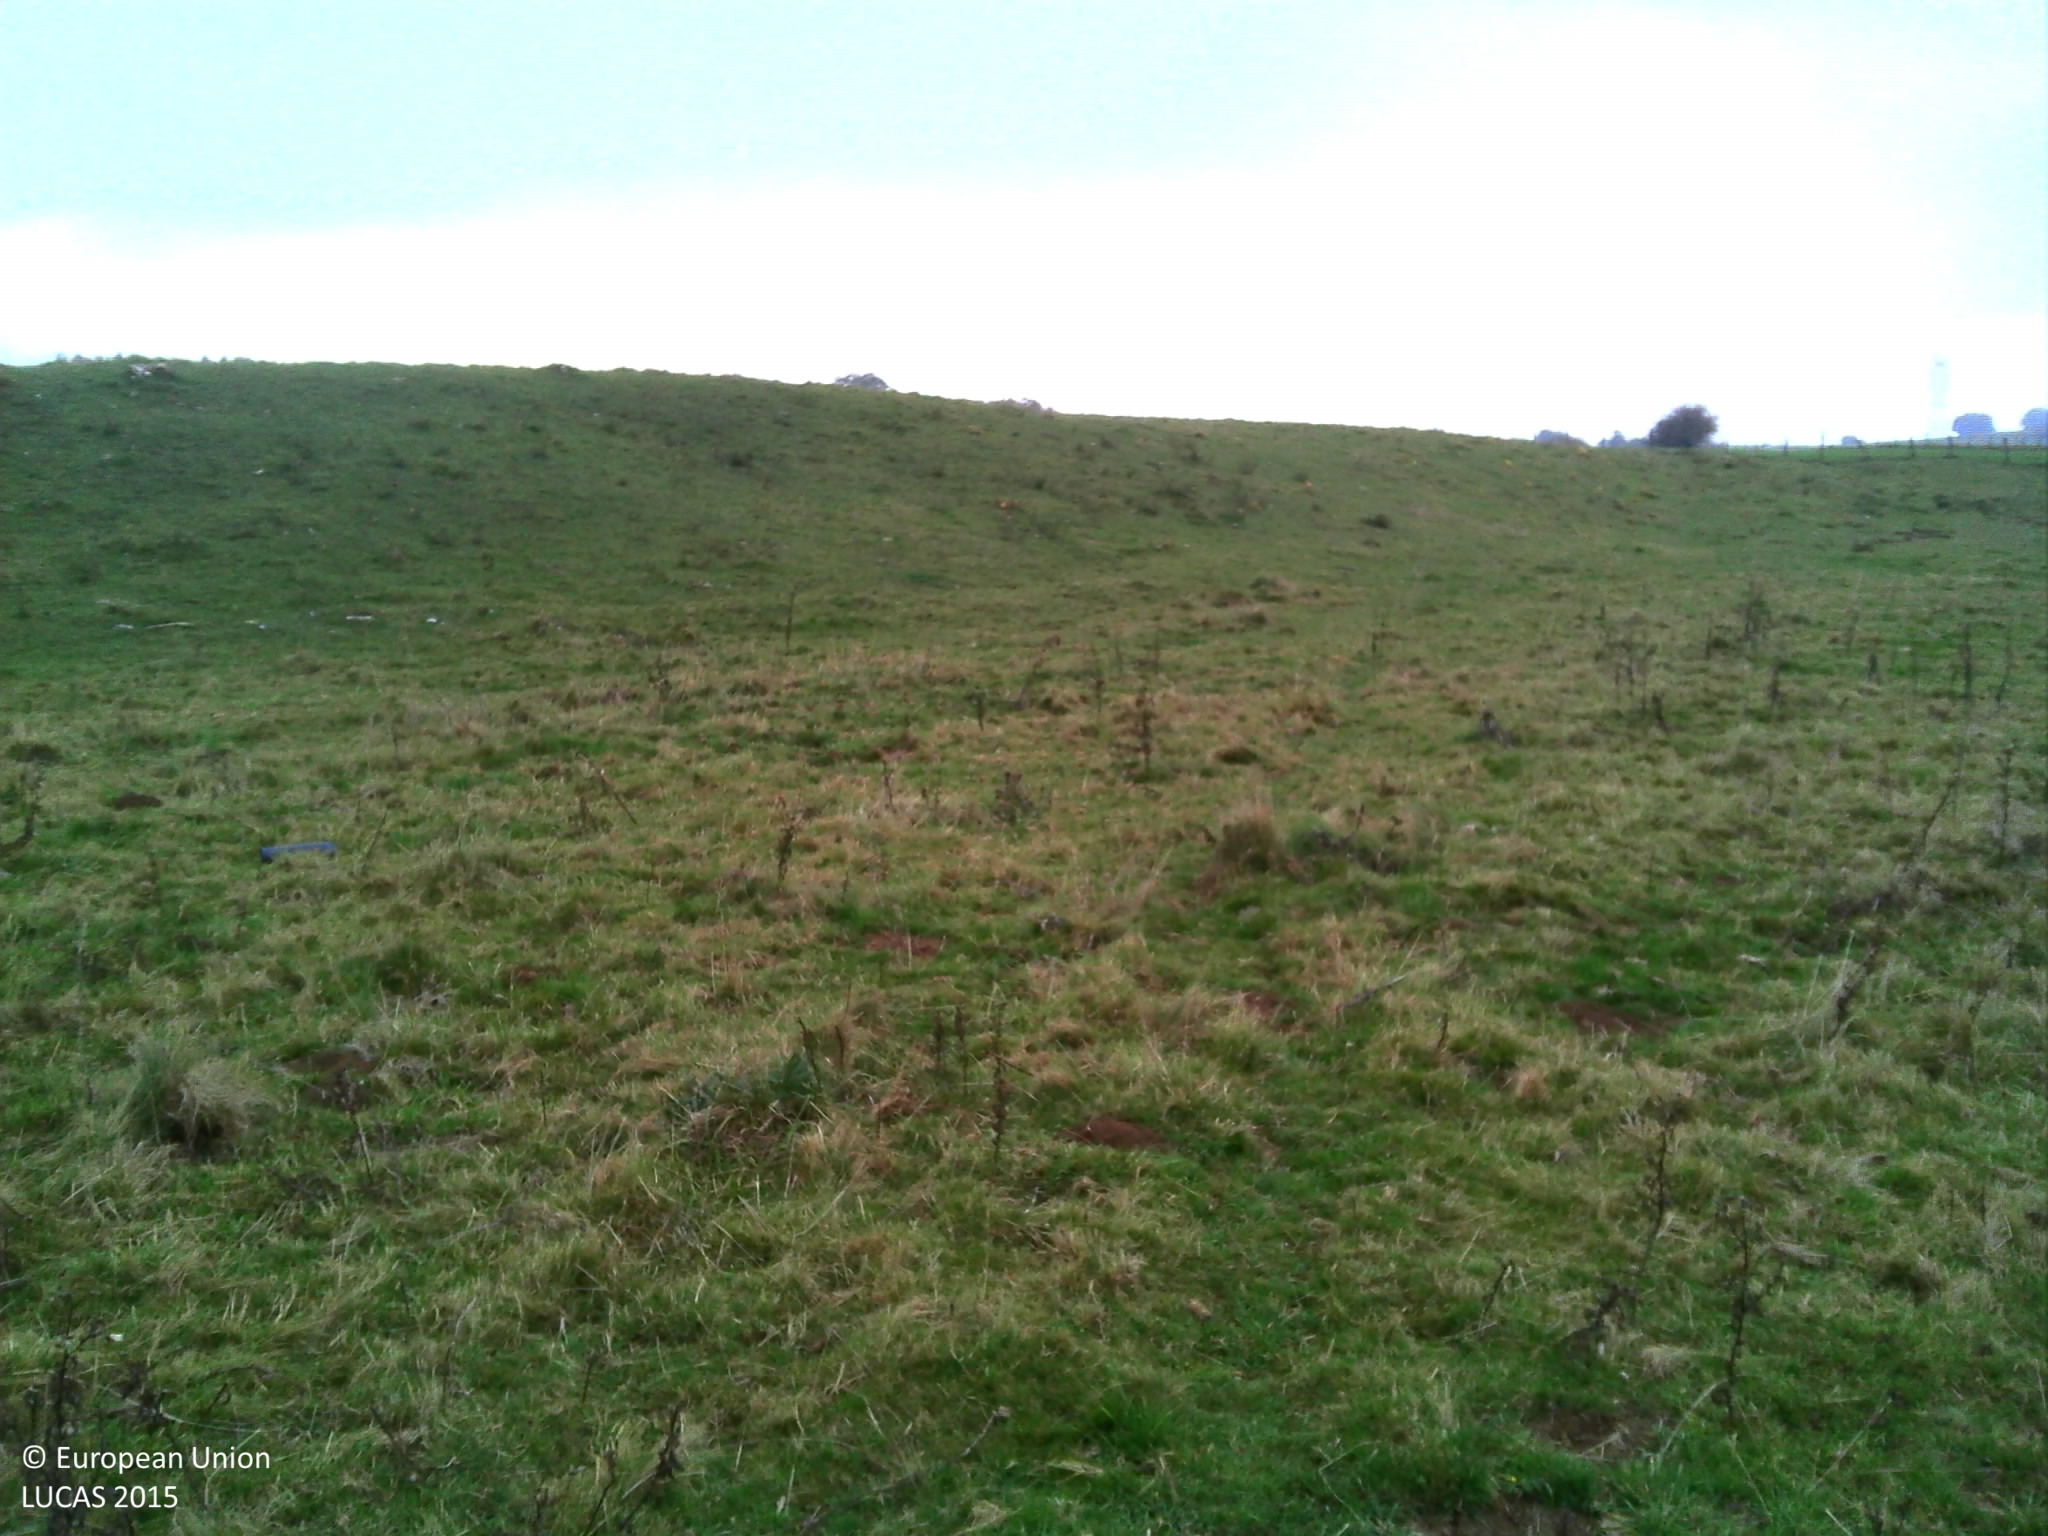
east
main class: Grassland
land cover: Grassland without tree/shrub cover
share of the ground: > 75 %
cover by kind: herbaceous plants 100 %
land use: Agriculture (excluding fallow land and kitchen gardens)
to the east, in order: Grassland without tree/shrub cover; Fences; Grassland without tree/shrub cover
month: October
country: FR
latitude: 46.8772
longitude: 6.1579
